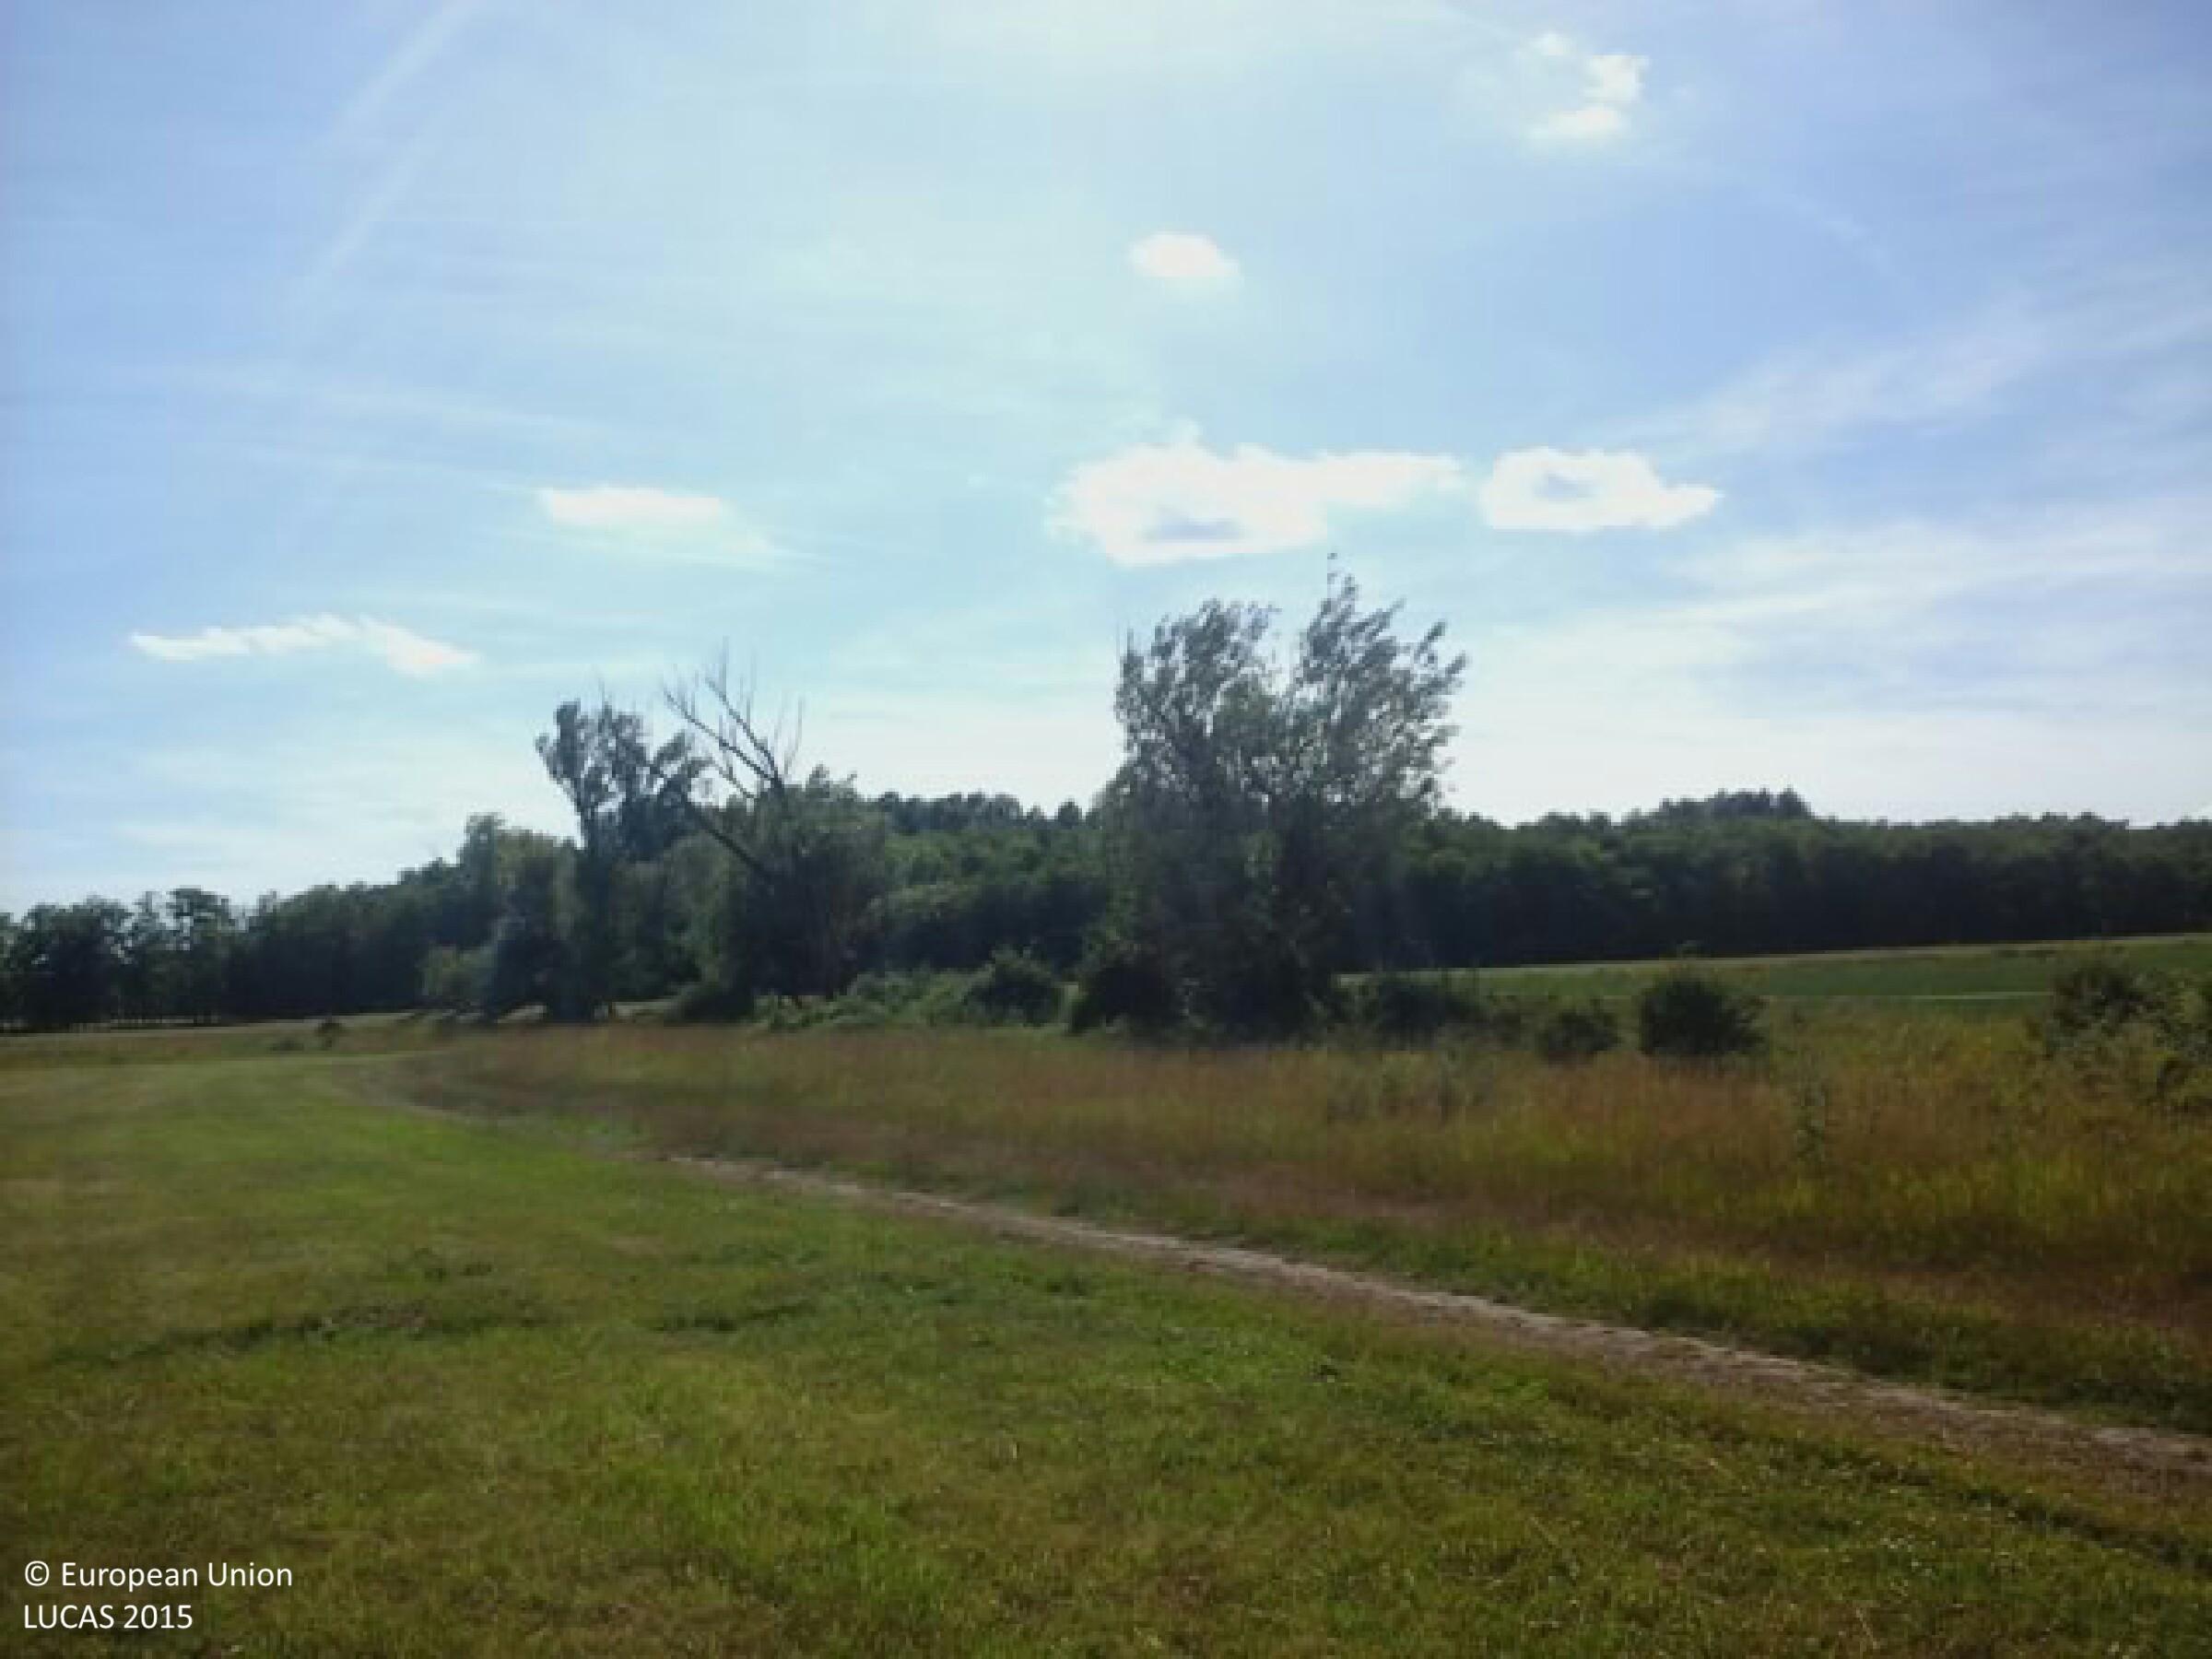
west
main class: Grassland
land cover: Grassland without tree/shrub cover
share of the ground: > 75 %
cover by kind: herbaceous plants 100 %
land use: Agriculture (excluding fallow land and kitchen gardens)
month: June
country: HU
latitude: 46.2811
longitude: 19.1898
